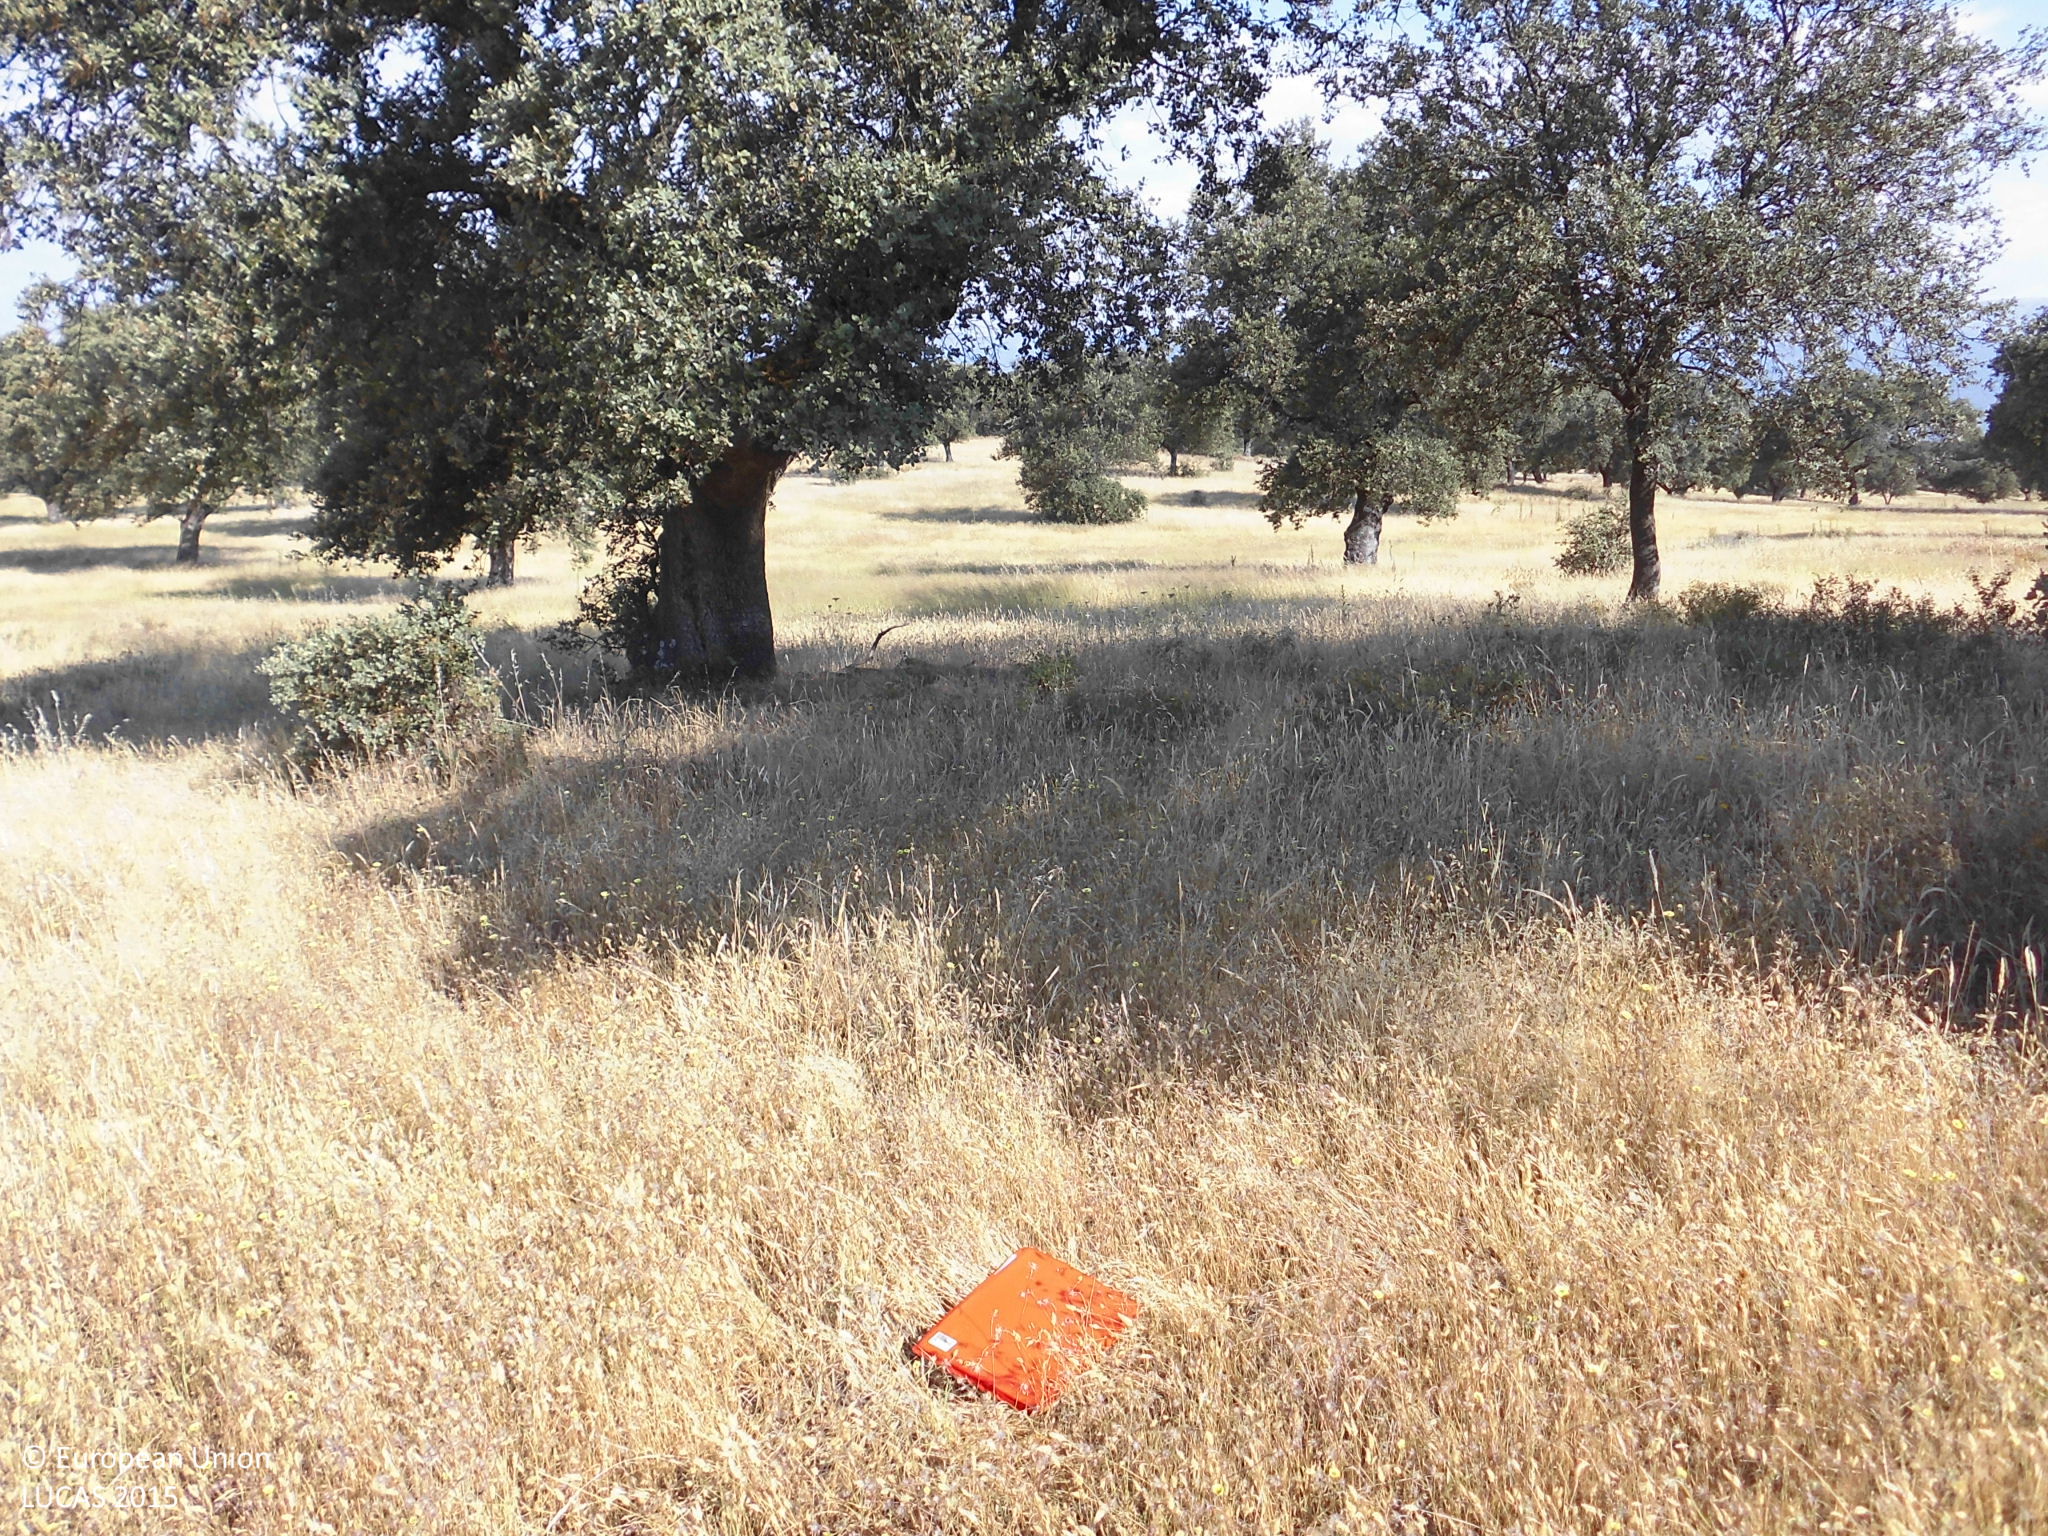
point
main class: Woodland
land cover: Broadleaved woodland
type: broadleaved evergreen forest
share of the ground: 50 - 75 %
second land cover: Grassland without tree/shrub cover
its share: > 75 %
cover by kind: herbaceous plants 70 %, broadleaved forest trees 25 %, shrubs 5 %
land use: Forestry
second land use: Agriculture (excluding fallow land and kitchen gardens)
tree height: > 5 m
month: June
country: ES
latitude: 40.0322
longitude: -5.4222
